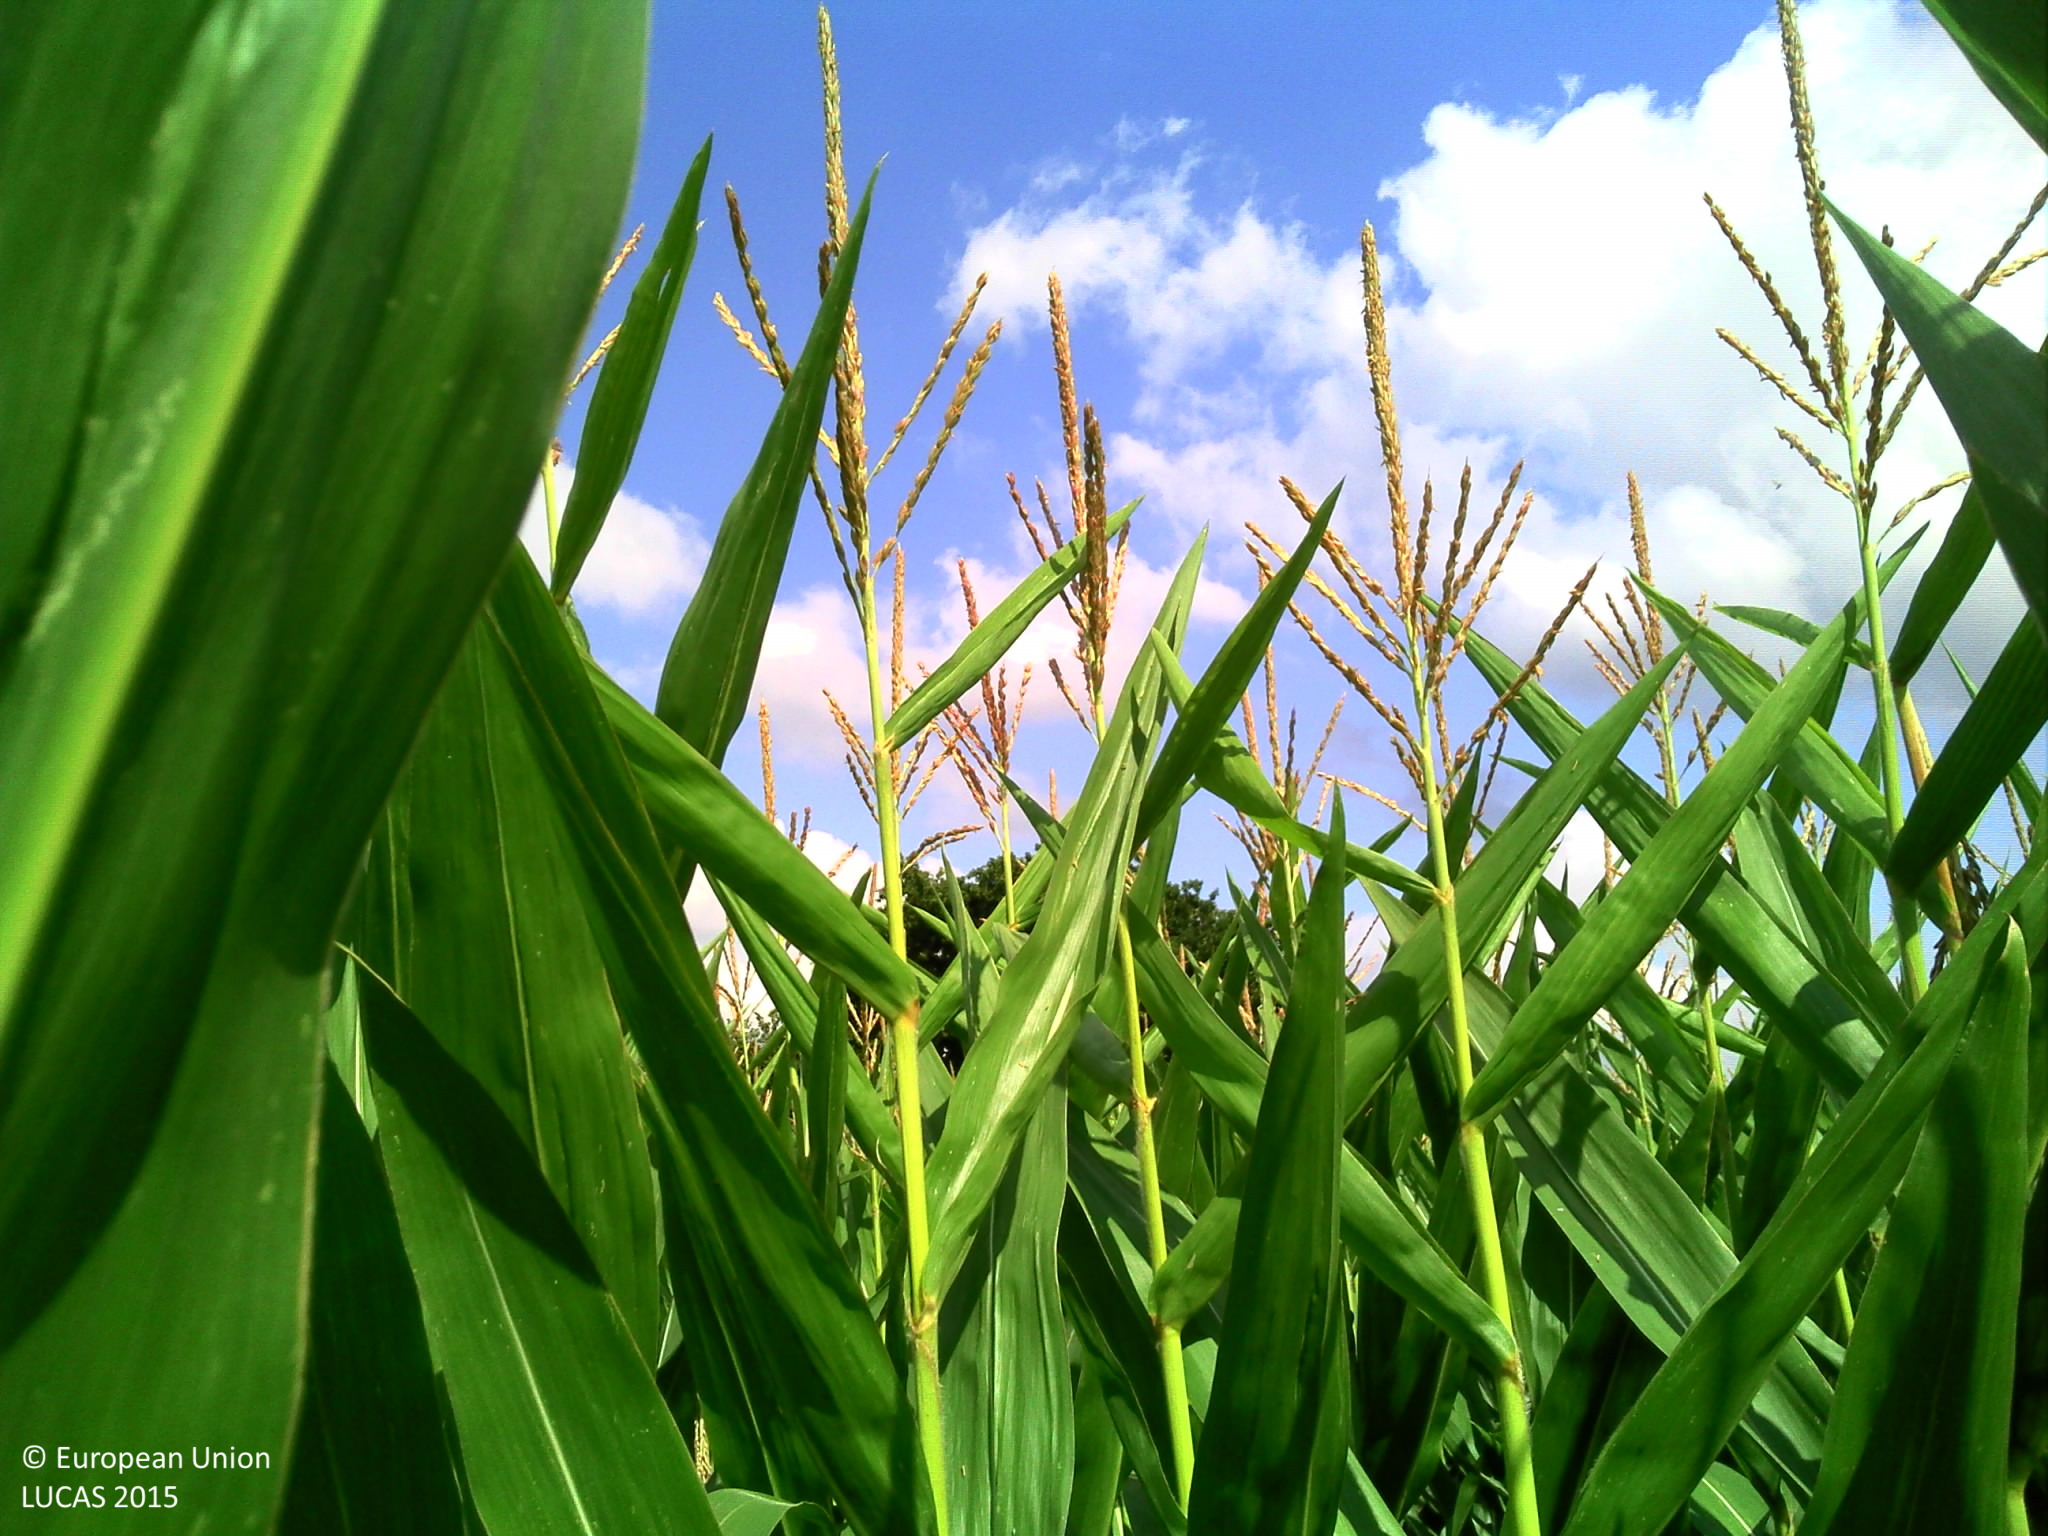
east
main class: Cropland
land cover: Maize
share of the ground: > 75 %
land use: Agriculture (excluding fallow land and kitchen gardens)
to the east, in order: Maize; Apple fruit; Abandoned hedges; Lines of trees; Maize; Fences; Grass margins; Tracks; Grass margins; Fences; Ditches and canals; Grass margins; Fences; Grassland without tree/shrub cover; Artificial constructions in urban areas; Grassland without tree/shrub cover; Lines of trees; Dry stone walls; Durum wheat
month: August
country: FR
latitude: 48.3156
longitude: -2.1242
